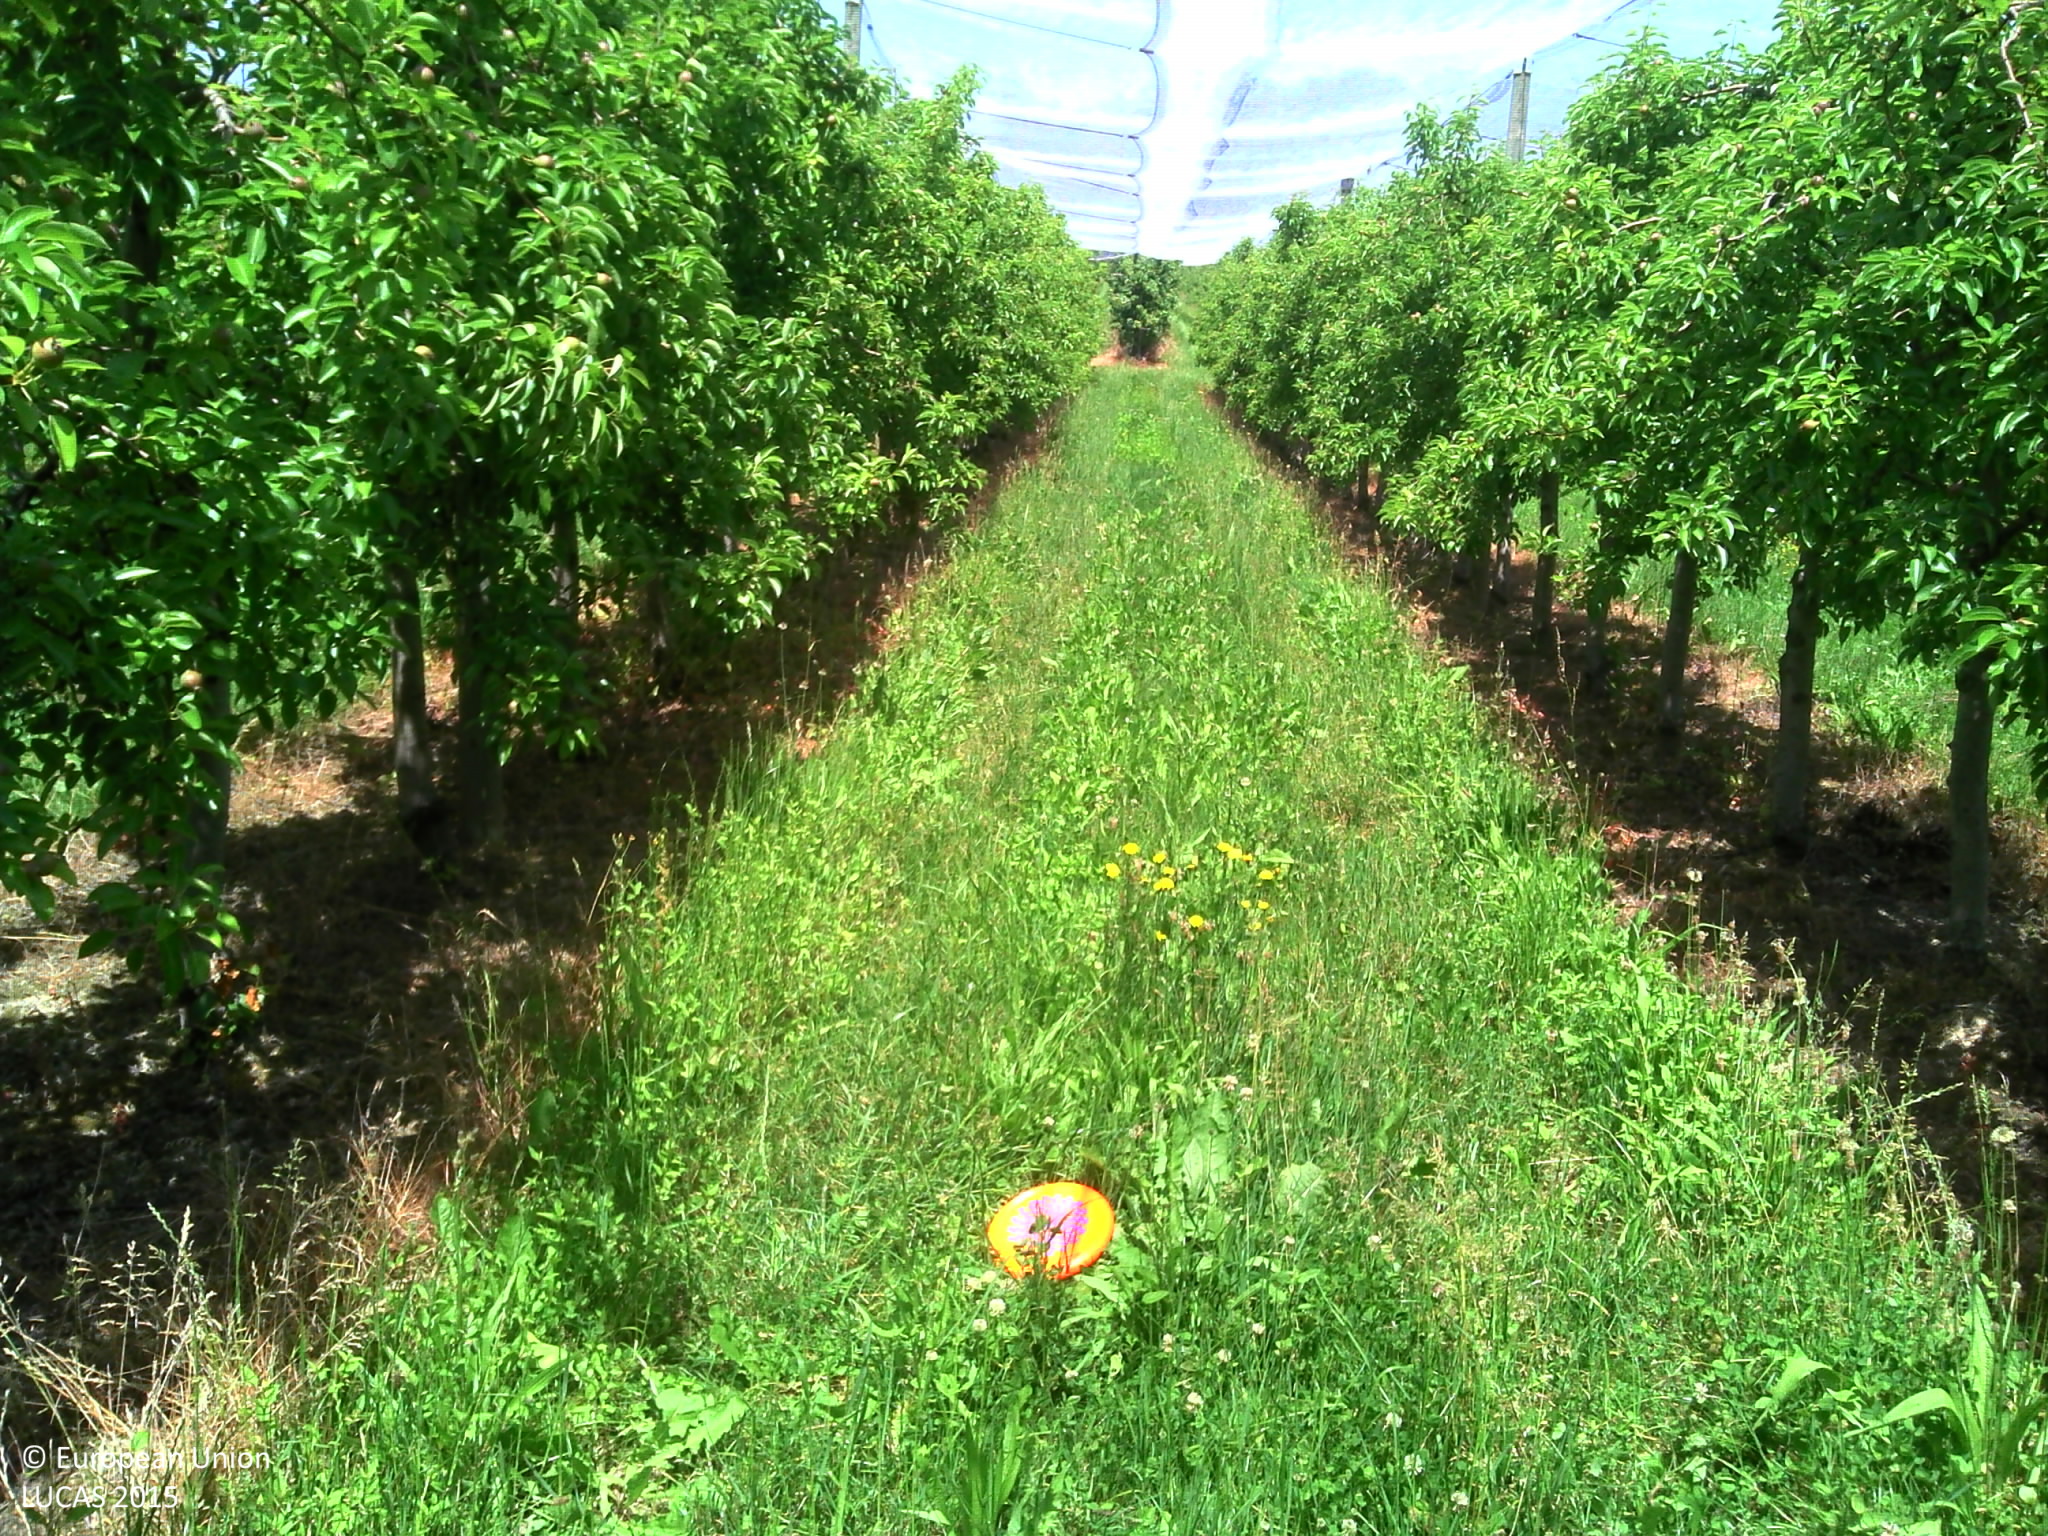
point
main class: Cropland
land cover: Pear fruit
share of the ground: 50 - 75 %
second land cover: Grassland without tree/shrub cover
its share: 50 - 75 %
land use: Agriculture (excluding fallow land and kitchen gardens)
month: June
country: FR
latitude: 46.4802
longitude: 4.8569
